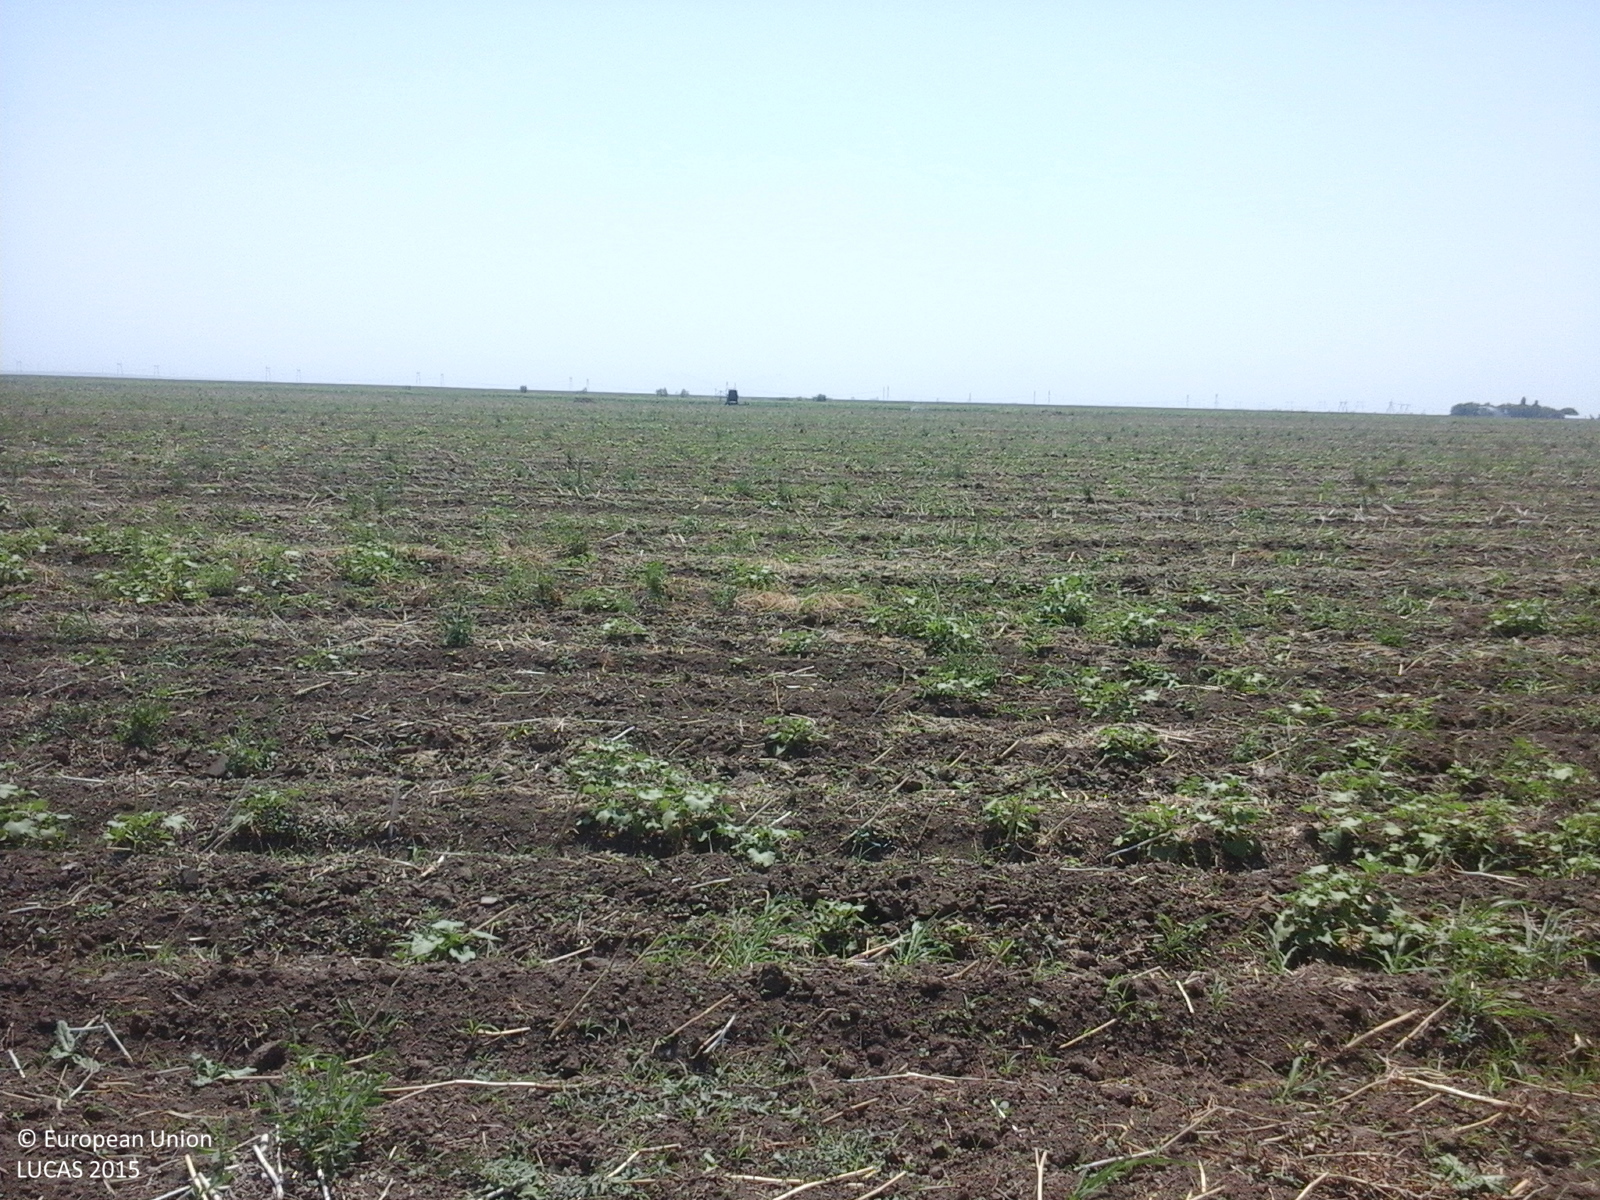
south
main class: Cropland
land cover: Common wheat
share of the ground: > 75 %
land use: Agriculture (excluding fallow land and kitchen gardens)
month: July
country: RO
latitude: 44.7367
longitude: 27.6657
